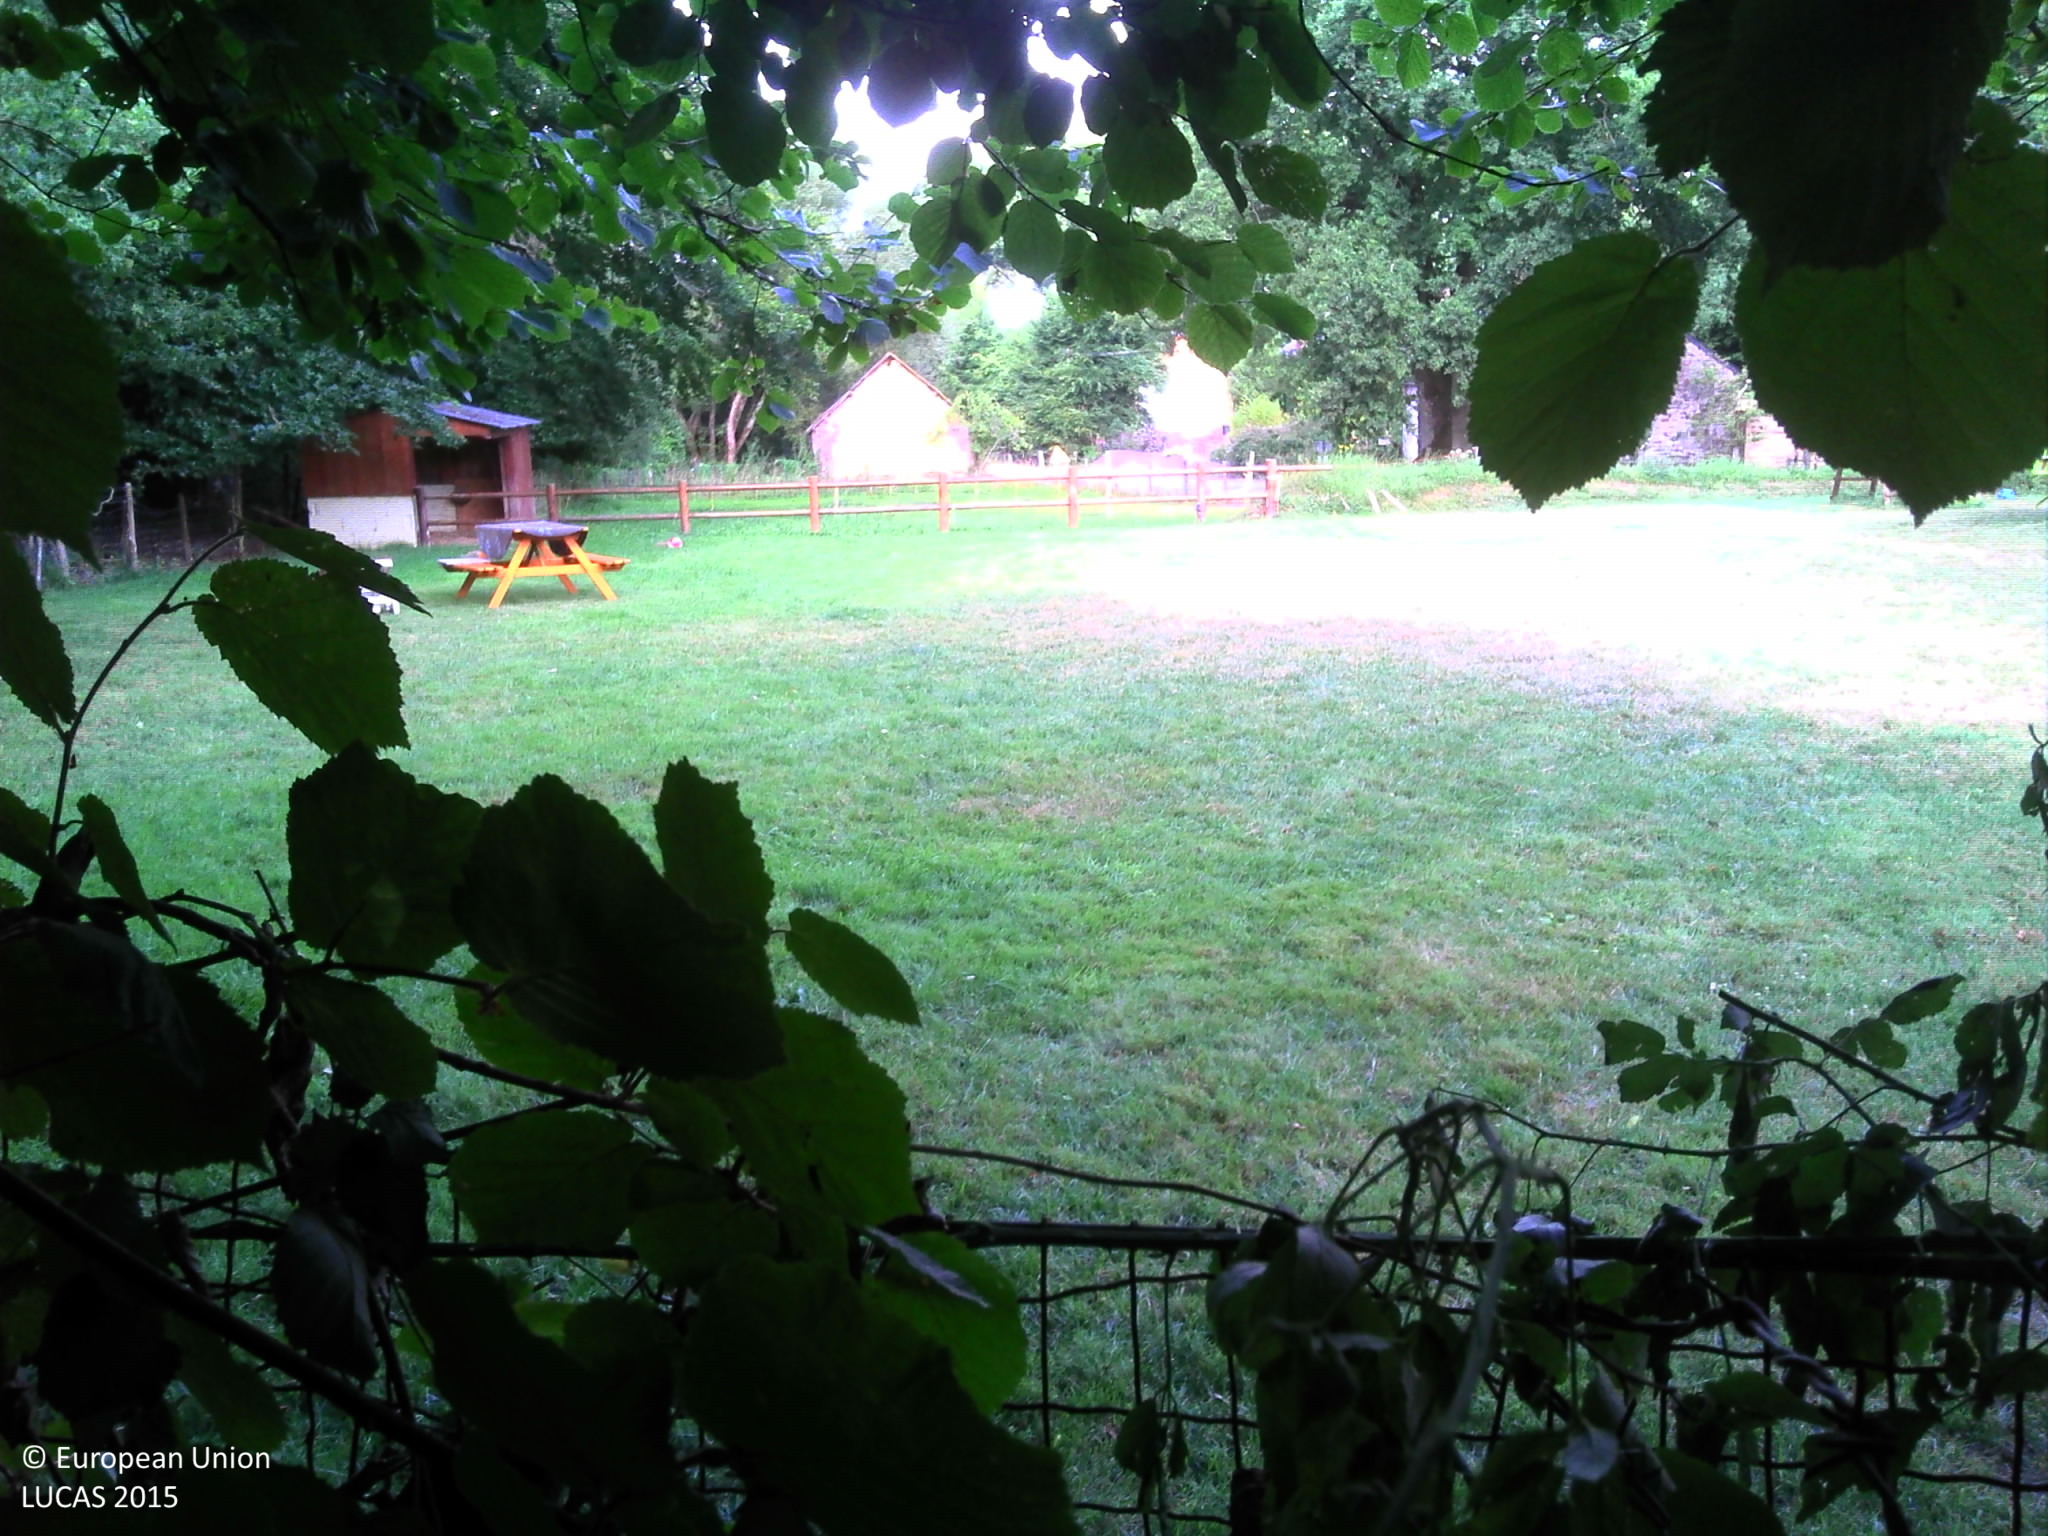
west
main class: Woodland
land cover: Broadleaved woodland
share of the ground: > 75 %
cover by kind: broadleaved forest trees 90 %, herbaceous plants 10 %
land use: Residential
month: July
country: FR
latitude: 47.5180
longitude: -1.9341
